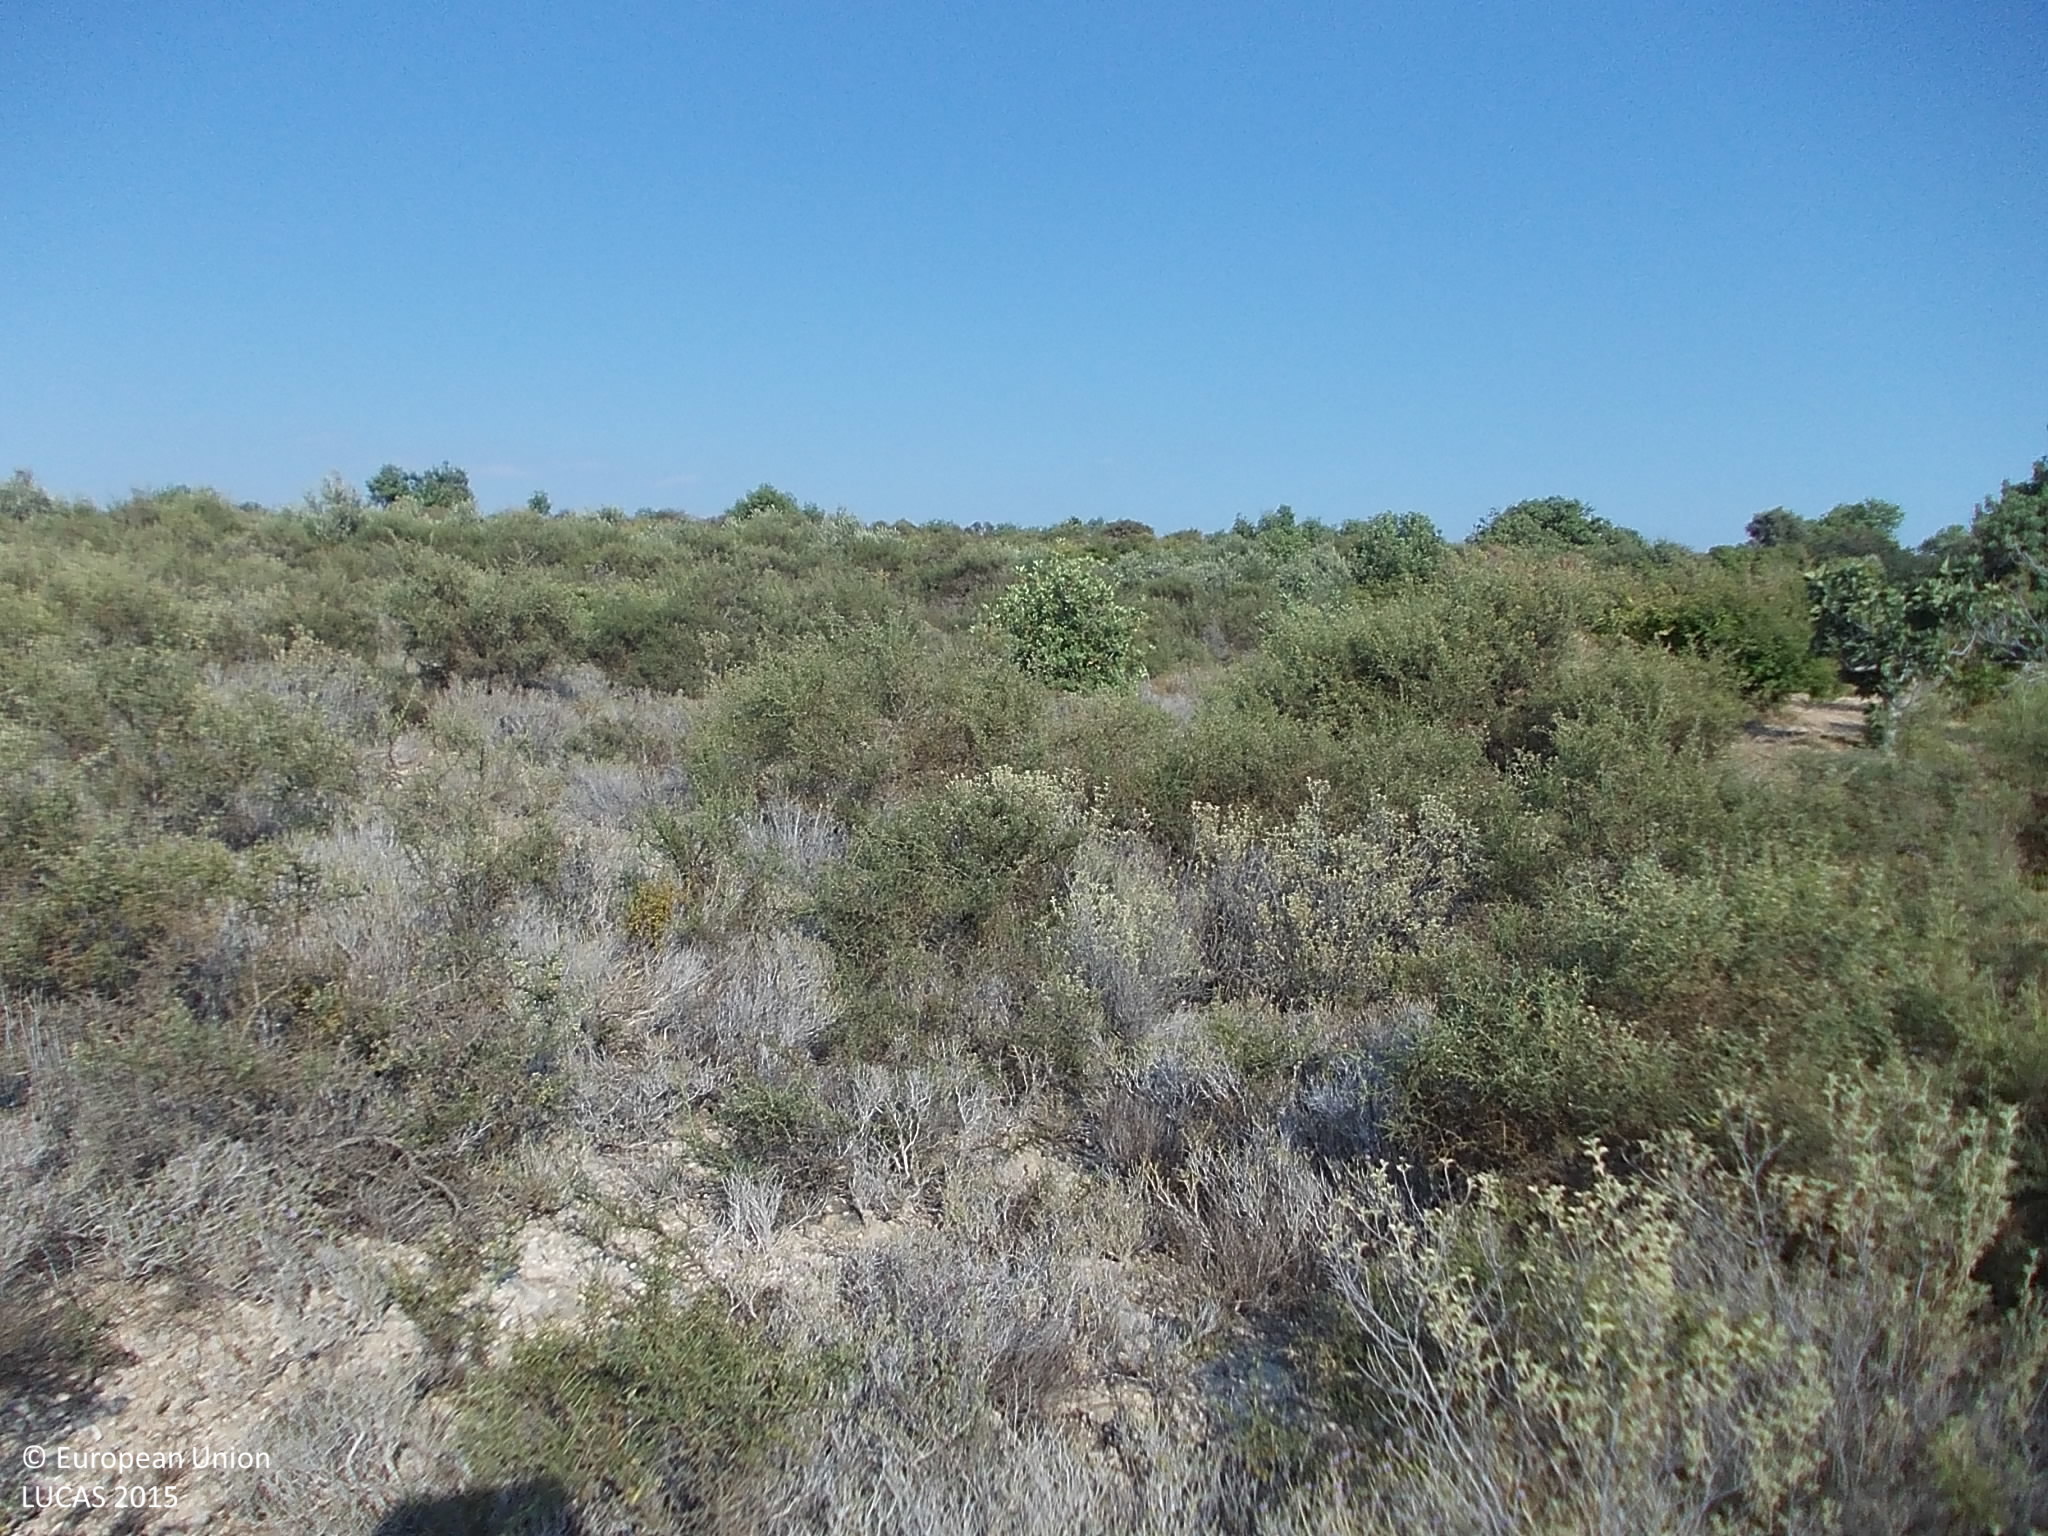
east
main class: Shrubland
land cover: Shrubland without tree cover
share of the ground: > 75 %
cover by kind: shrubs 90 %, unconsolidated bare surface 10 %
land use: Semi-natural and natural areas not in use
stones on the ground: 10 - 25 %
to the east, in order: Shrubland without tree cover; Olive groves; Nuts trees; Shrubland without tree cover; Nuts trees; Shrubland without tree cover; Nuts trees; Shrubland without tree cover
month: August
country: CY
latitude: 34.7543
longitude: 33.0084
